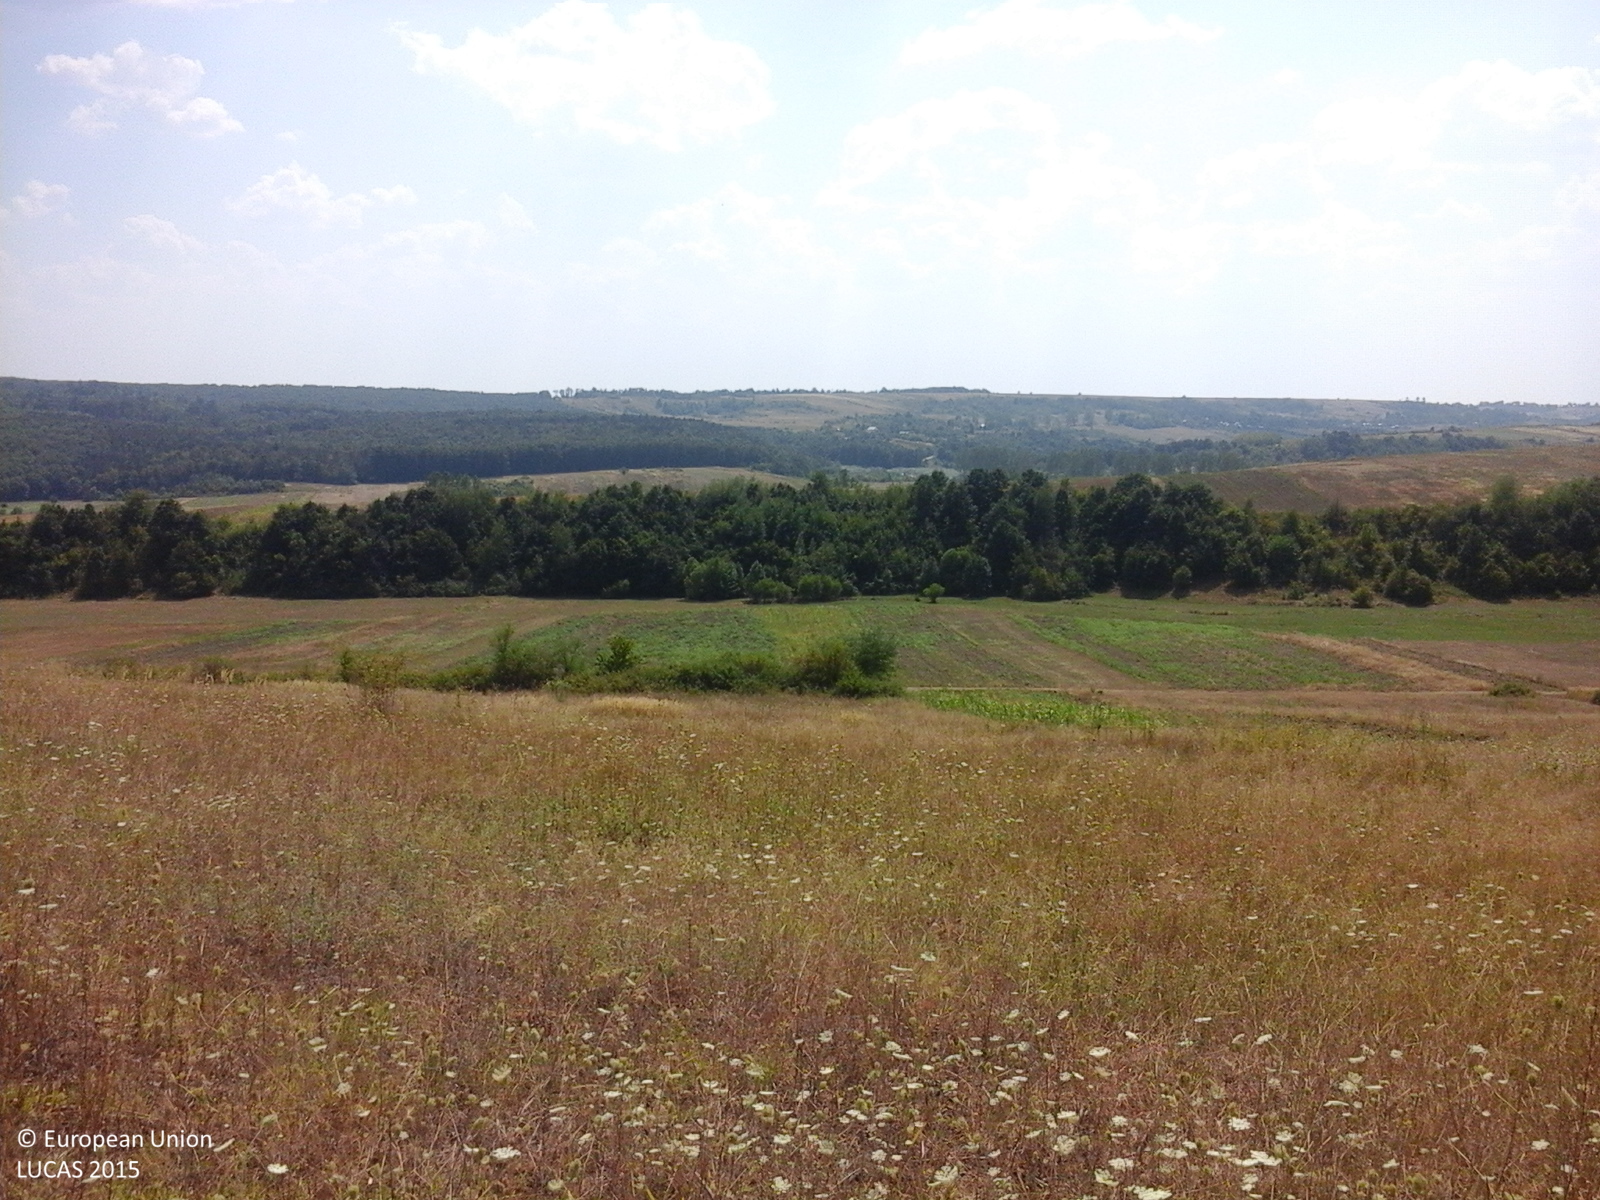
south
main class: Grassland
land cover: Spontaneously vegetated surfaces
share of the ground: > 75 %
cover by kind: herbaceous plants 100 %
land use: Fallow land
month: August
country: RO
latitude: 44.5130
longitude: 23.2966
